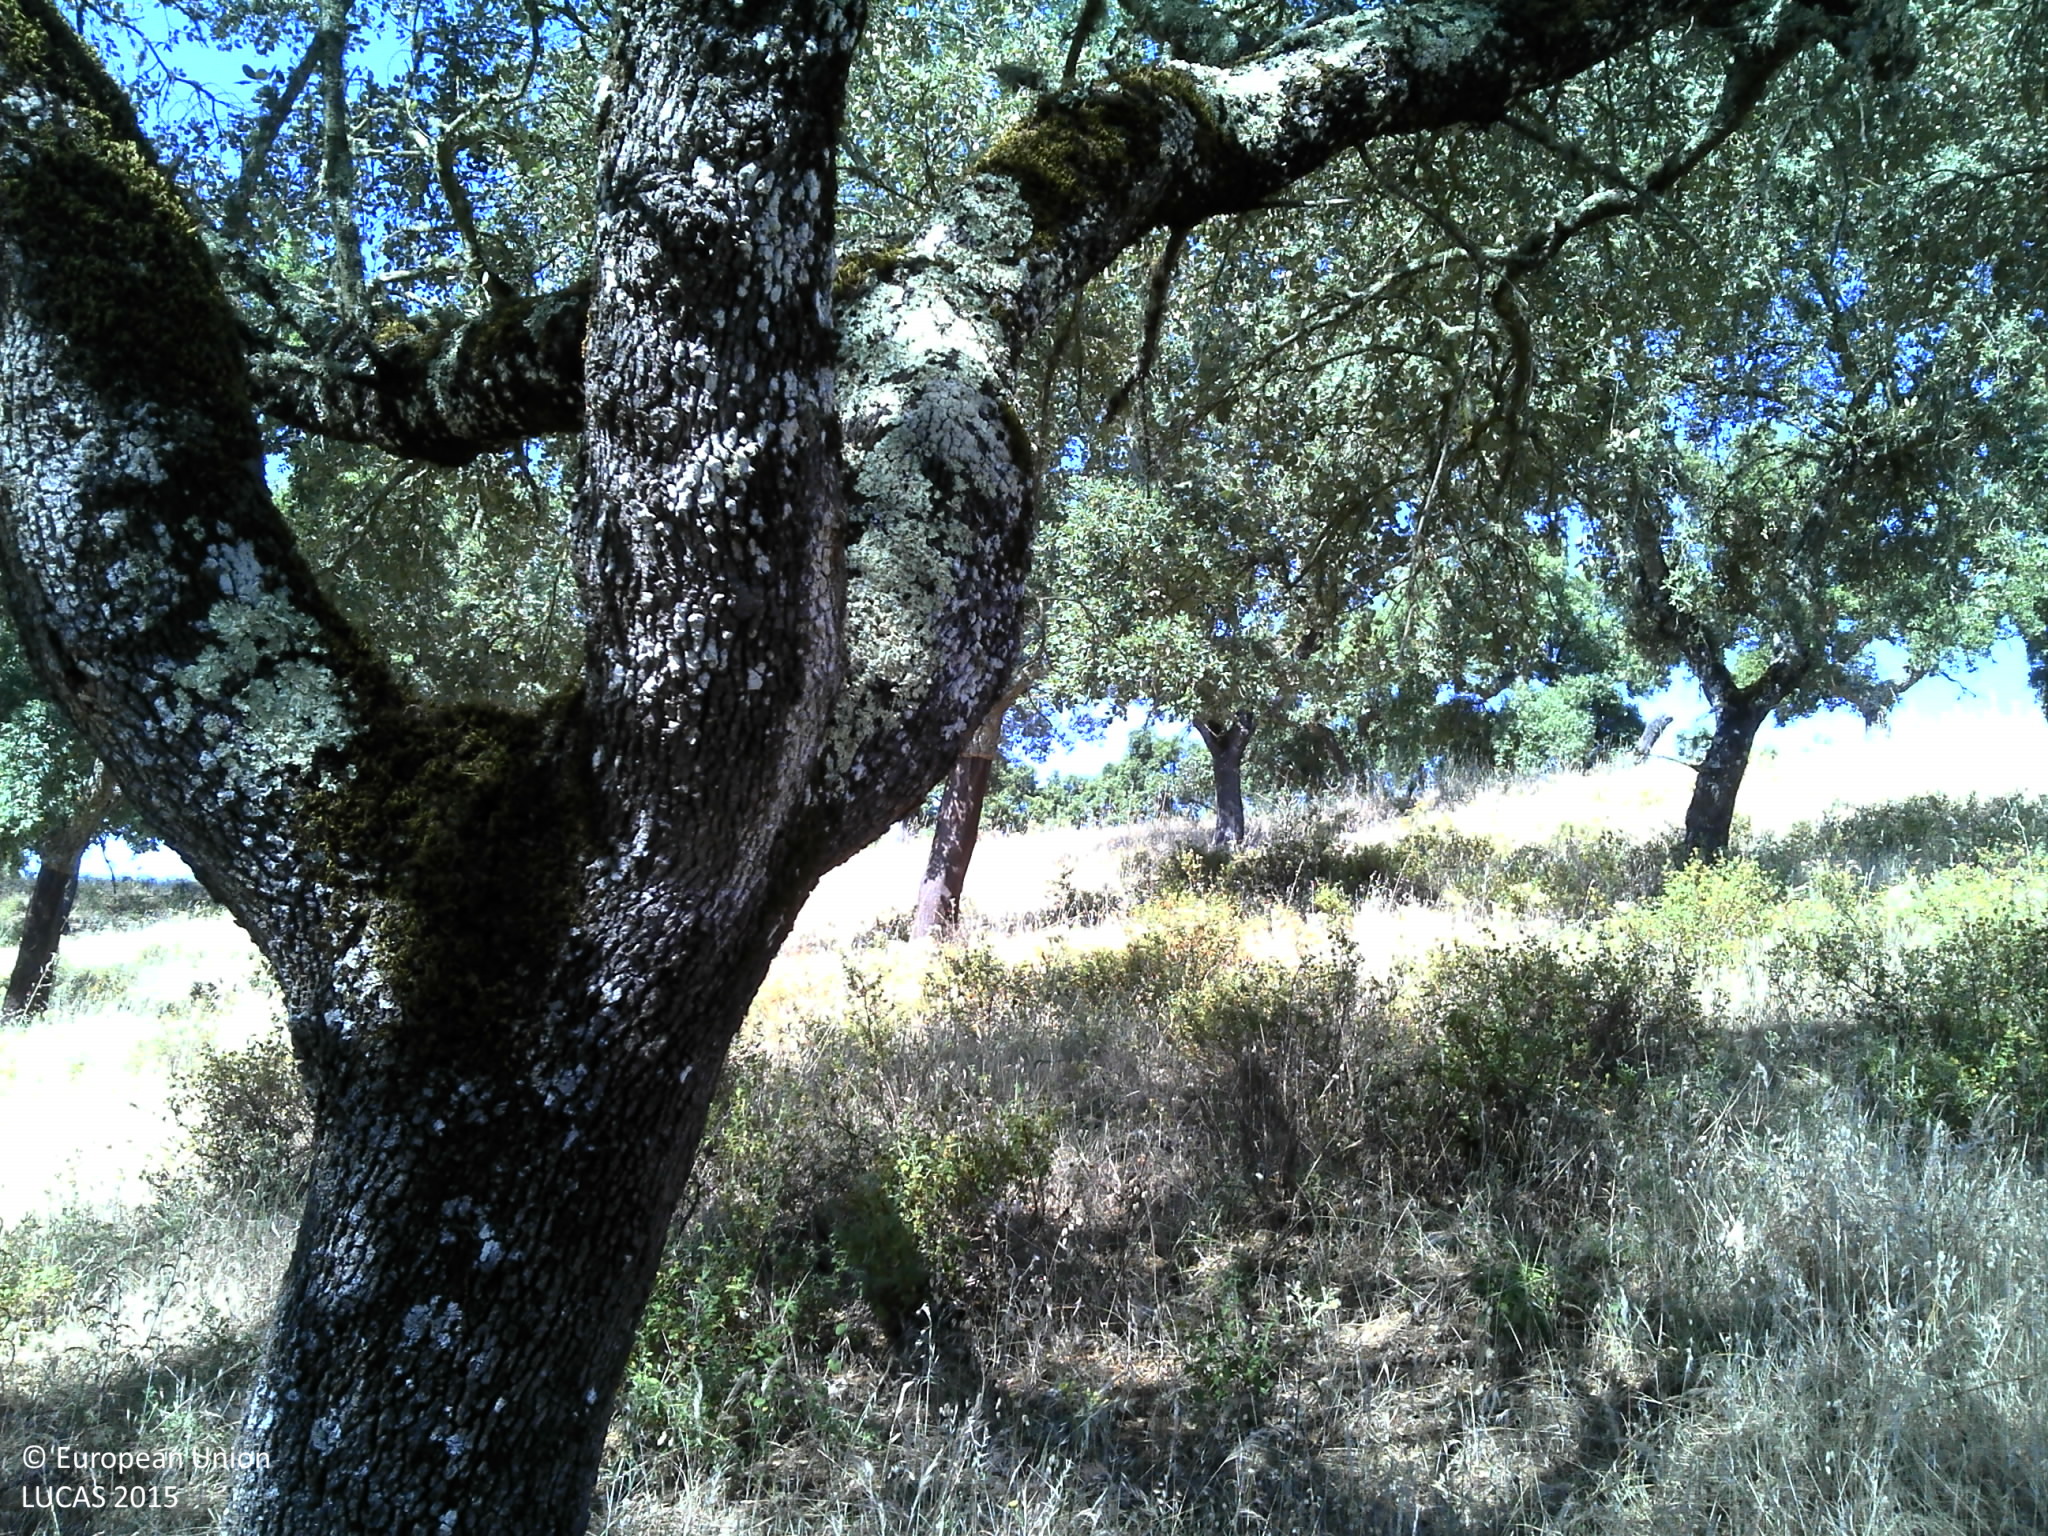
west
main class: Woodland
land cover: Broadleaved woodland
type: broadleaved evergreen forest
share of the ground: 50 - 75 %
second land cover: Grassland without tree/shrub cover
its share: 25 - 50 %
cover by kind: broadleaved forest trees 50 %, herbaceous plants 40 %, unconsolidated bare surface 10 %
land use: Forestry
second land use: Agriculture (excluding fallow land and kitchen gardens)
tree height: > 5 m
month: June
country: PT
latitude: 38.7790
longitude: -8.1564
